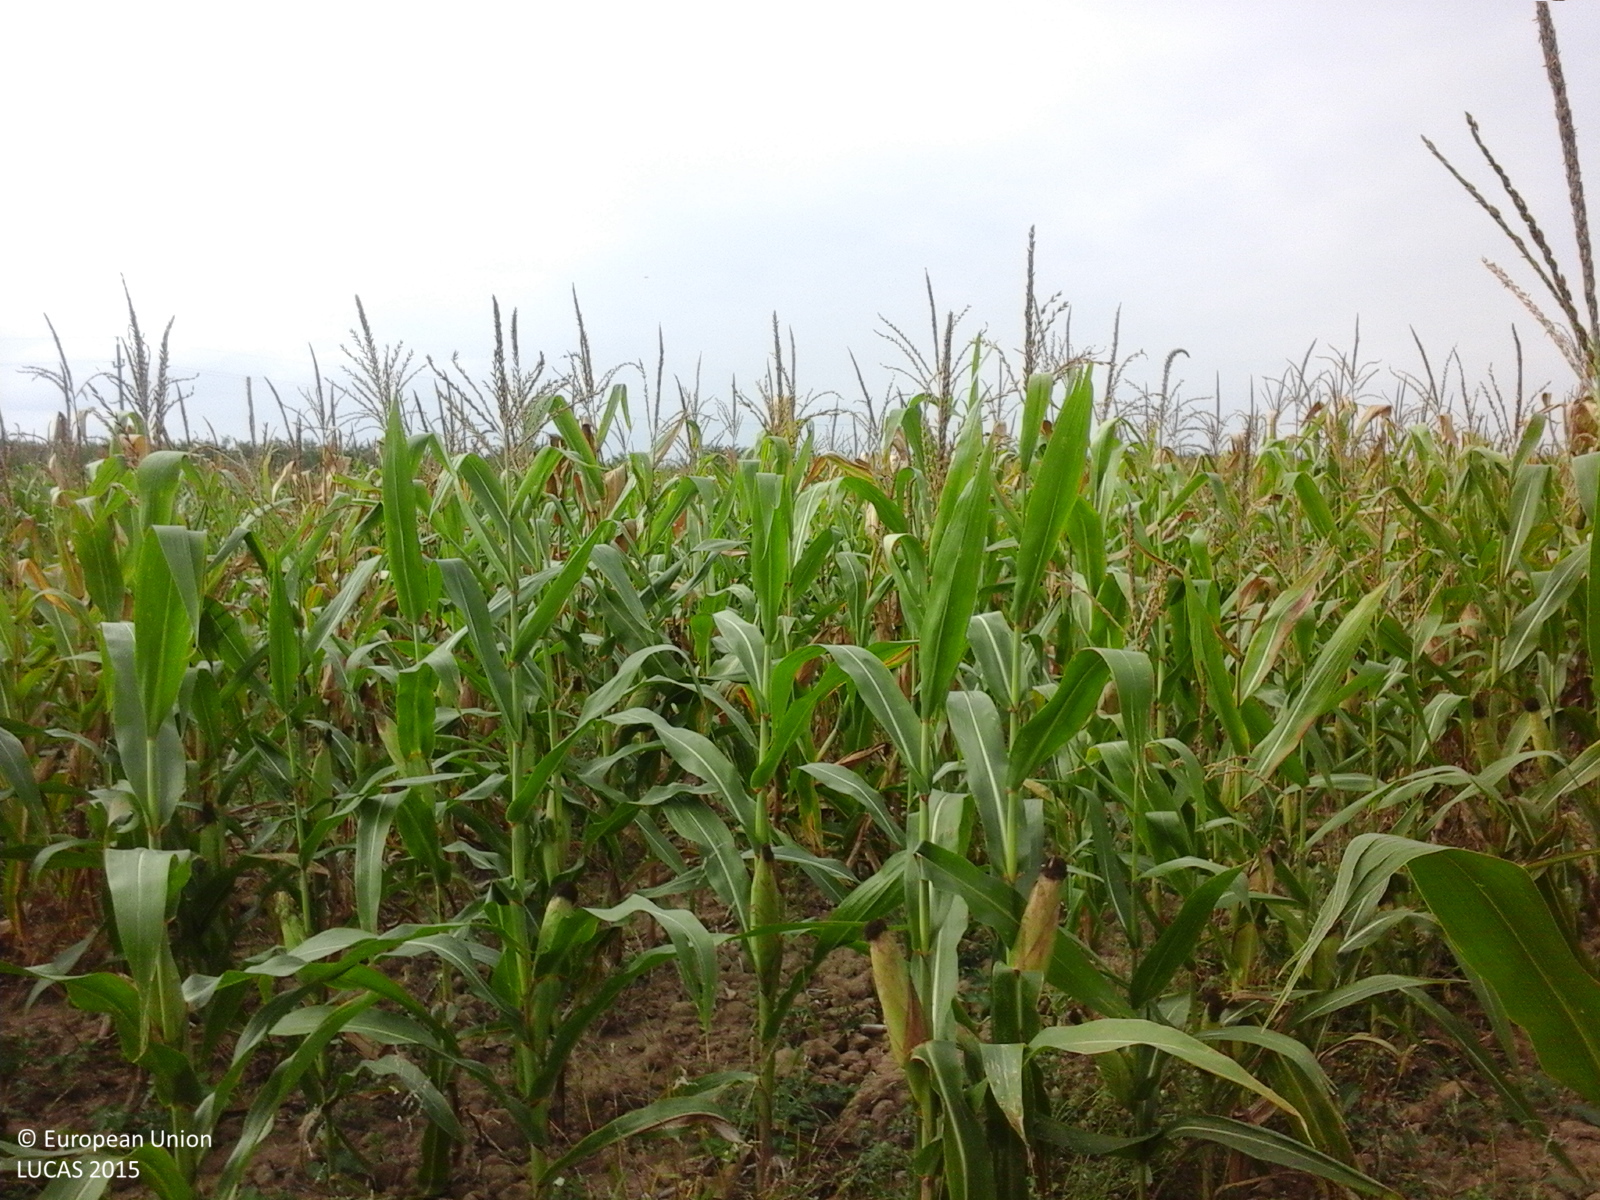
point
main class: Cropland
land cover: Maize
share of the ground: > 75 %
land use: Agriculture (excluding fallow land and kitchen gardens)
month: September
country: RO
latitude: 45.6620
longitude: 21.9362
